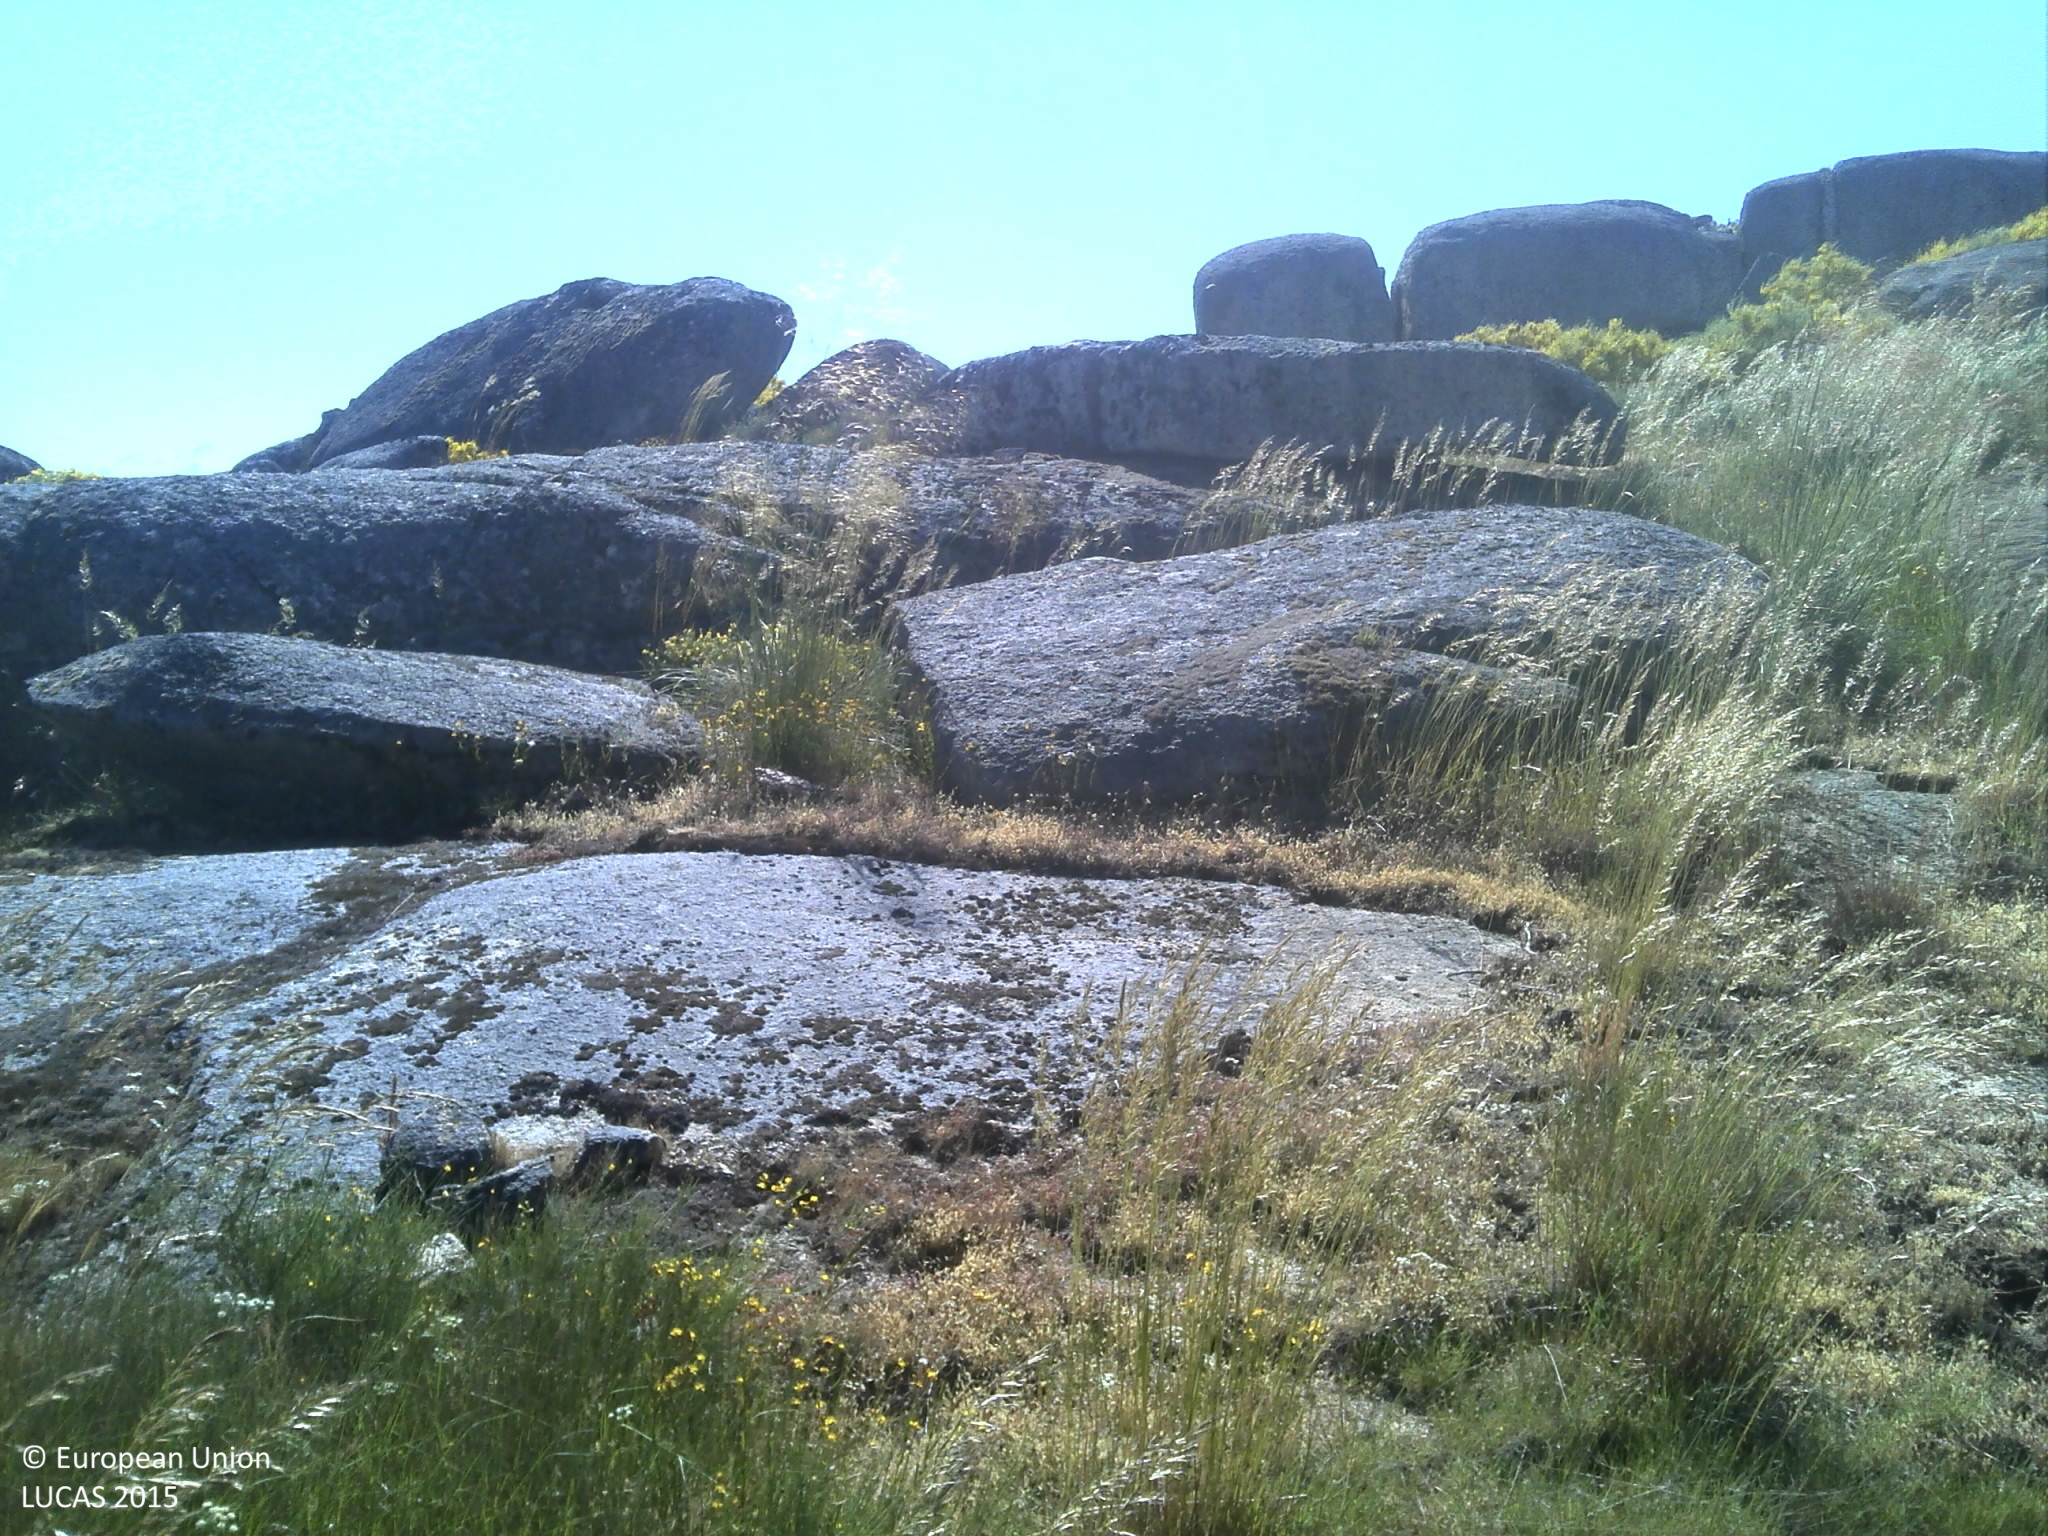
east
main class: Woodland
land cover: Other coniferous woodland
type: coniferous forest of the mediterranean region
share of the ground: 10 - 25 %
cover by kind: coniferous forest trees 25 %, shrubs 25 %, consolidated bare surface 25 %, herbaceous plants 20 %, unconsolidated bare surface 5 %
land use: Forestry
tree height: < 5 m
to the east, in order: Other coniferous woodland; Shrubland without tree cover; Rocks and stones; Shrubland without tree cover; Rocks and stones; Shrubland without tree cover; Rocks and stones; Shrubland with sparse tree cover; Rocks and stones; Shrubland with sparse tree cover
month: May
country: PT
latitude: 40.6015
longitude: -7.1813
